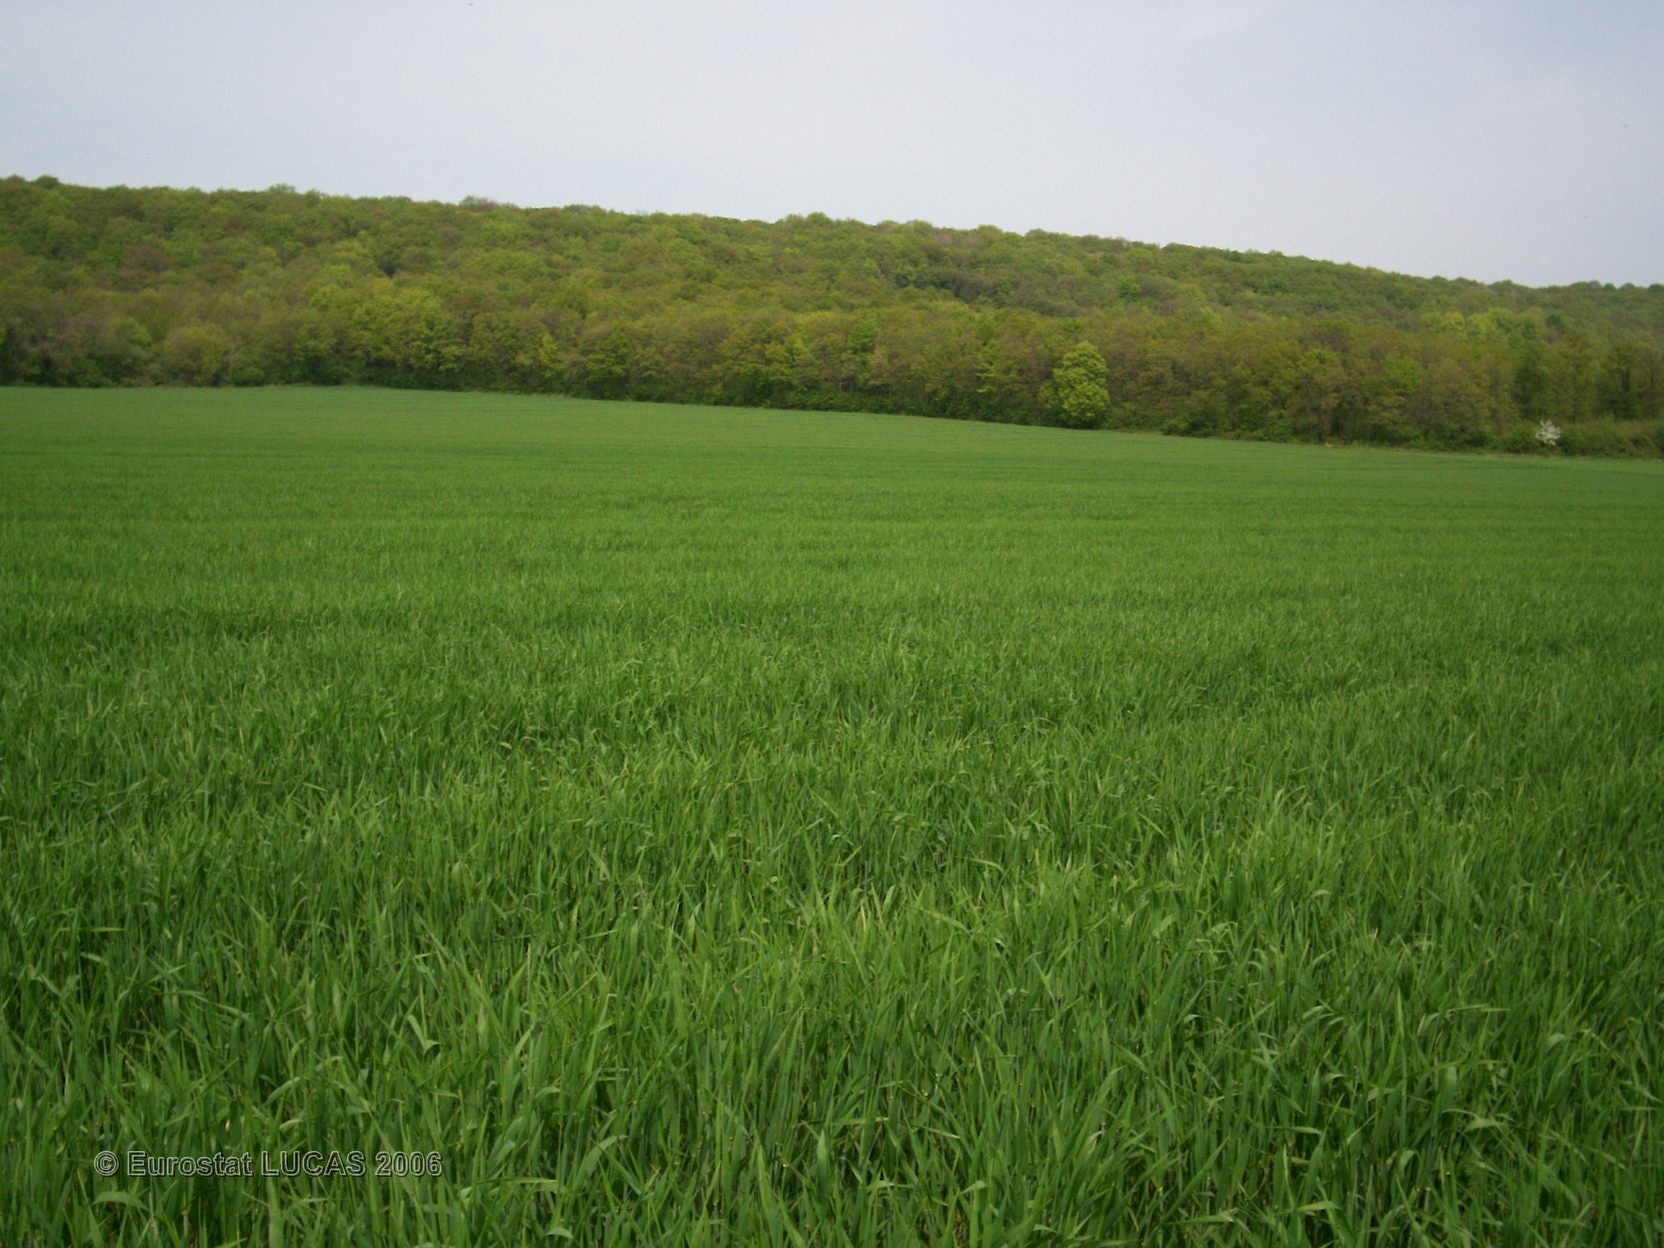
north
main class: Cropland
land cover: Barley
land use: Agriculture (excluding fallow land and kitchen gardens)
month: May
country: FR
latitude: 48.0855
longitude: 3.8071
